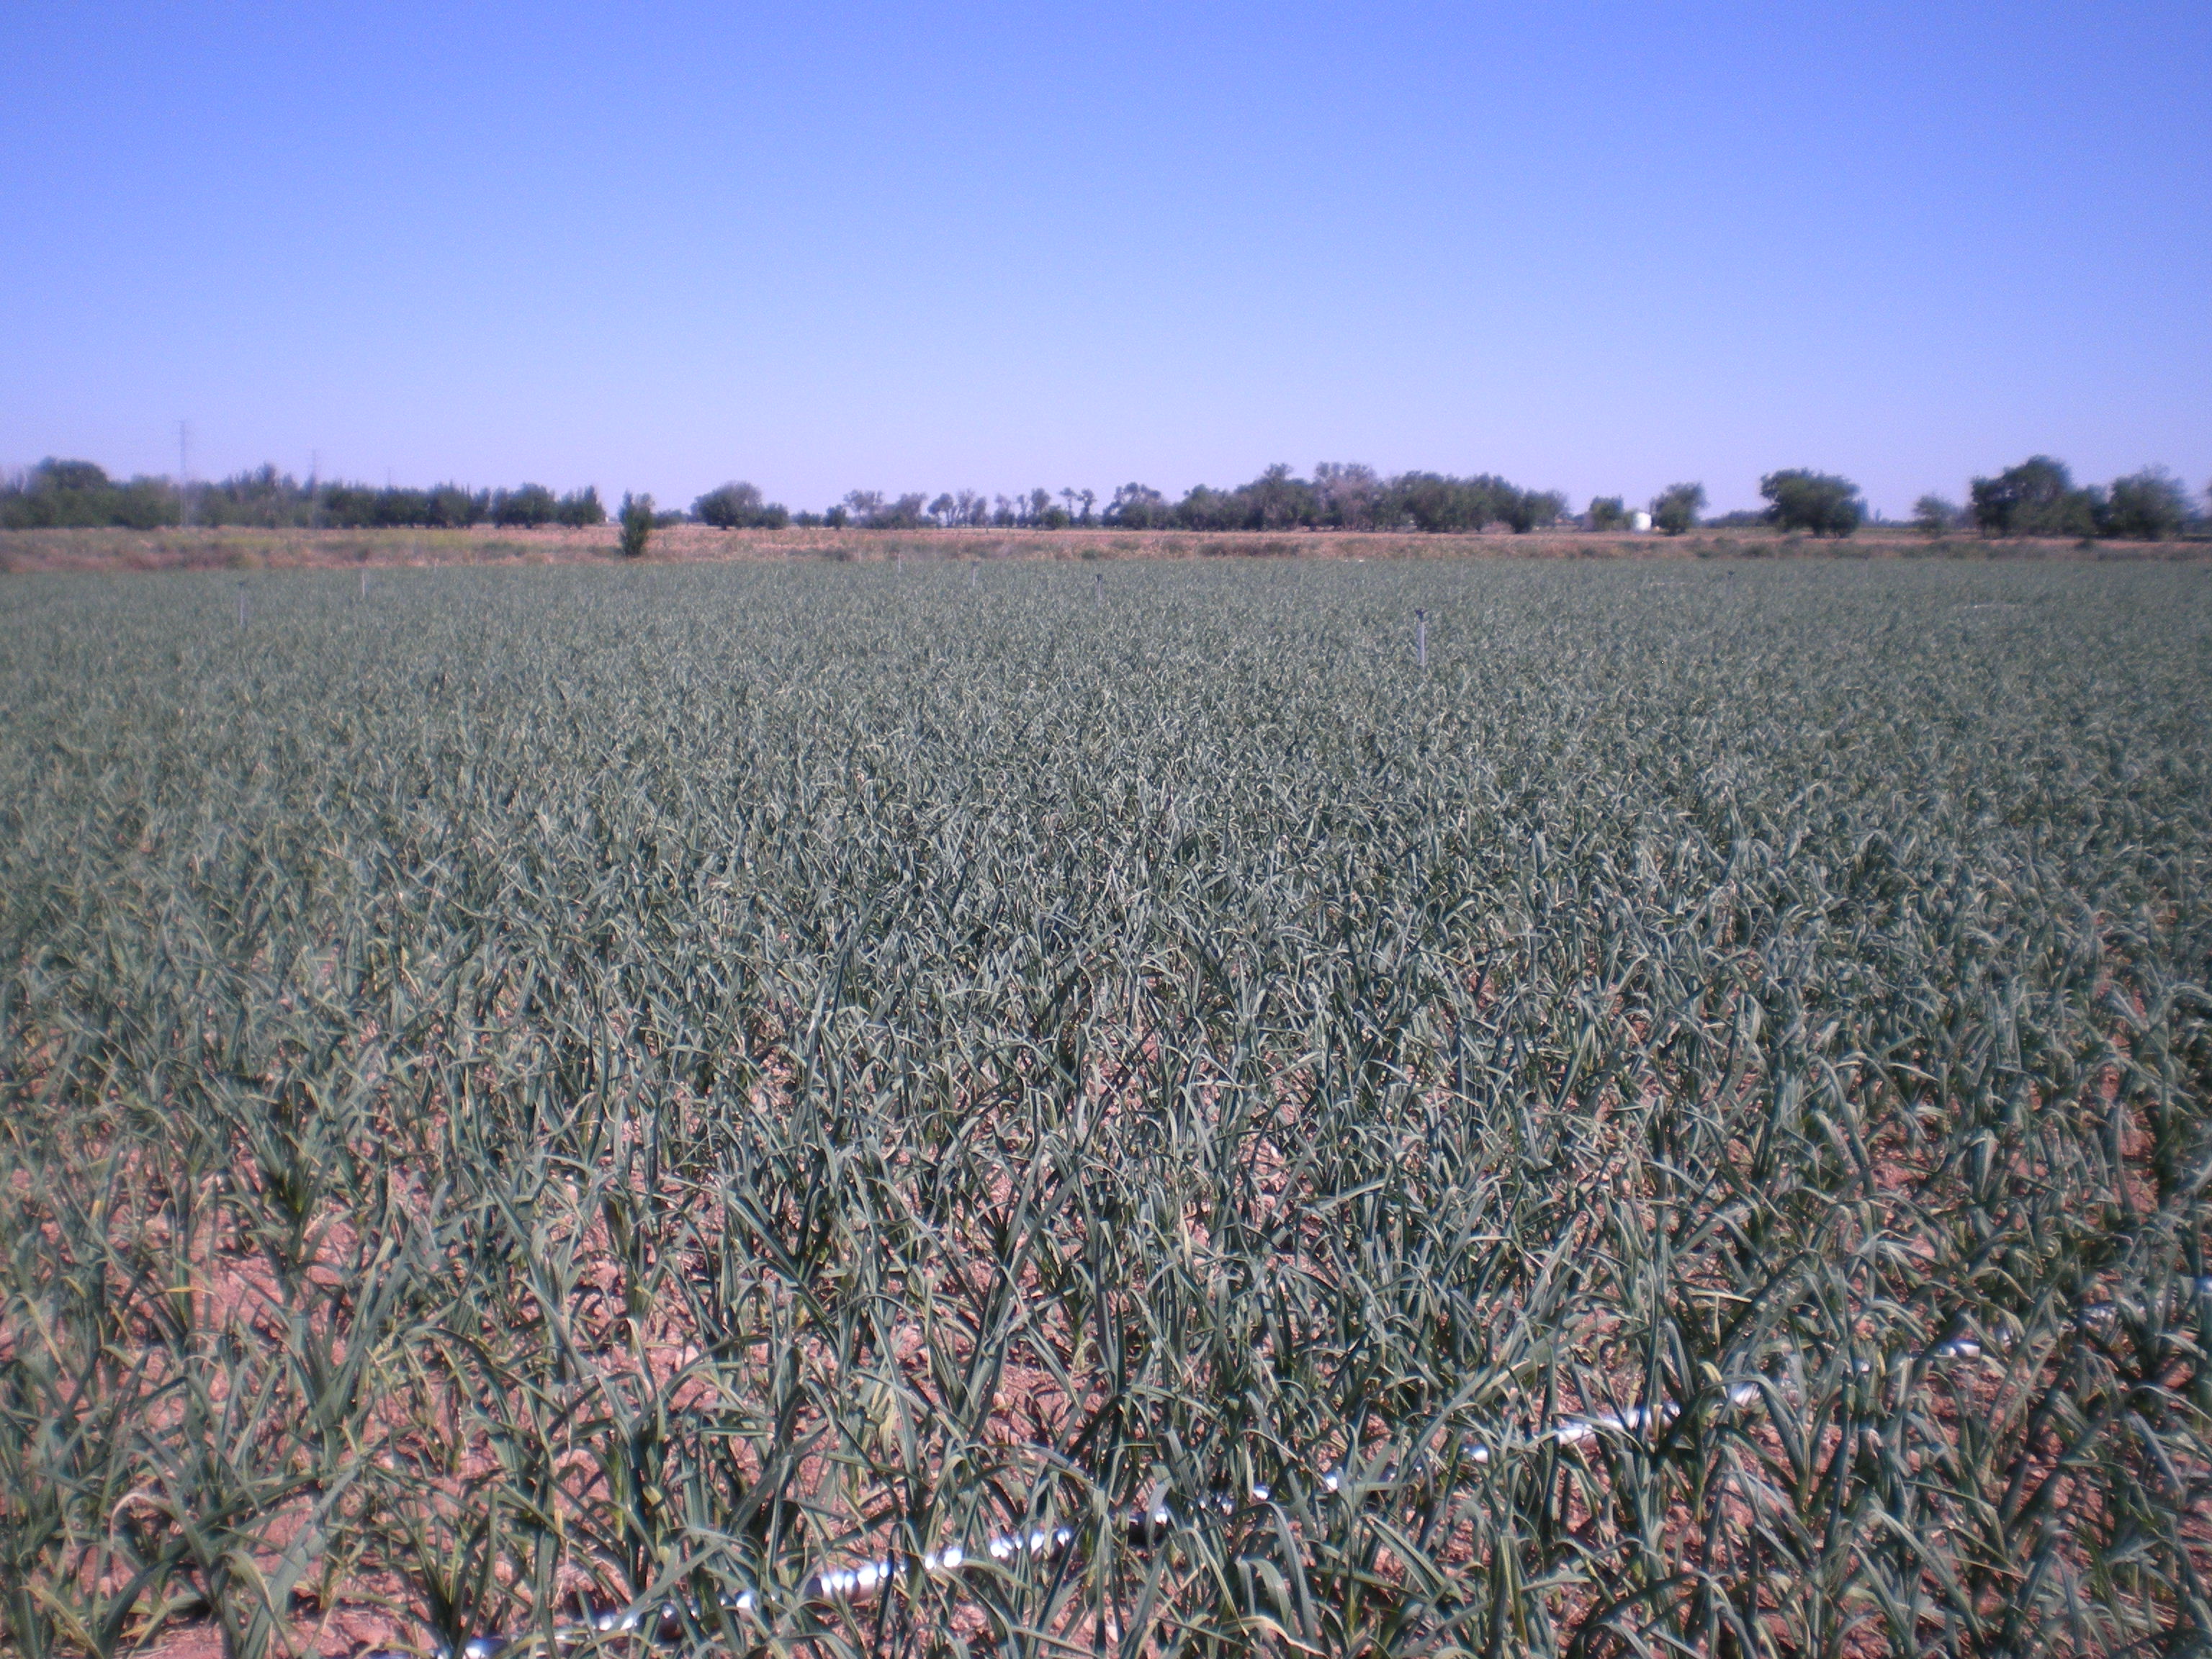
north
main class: Cropland
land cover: Other root crops
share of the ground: 50 - 75 %
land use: Agriculture (excluding fallow land and kitchen gardens)
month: May
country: ES
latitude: 39.0964
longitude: -3.0663
